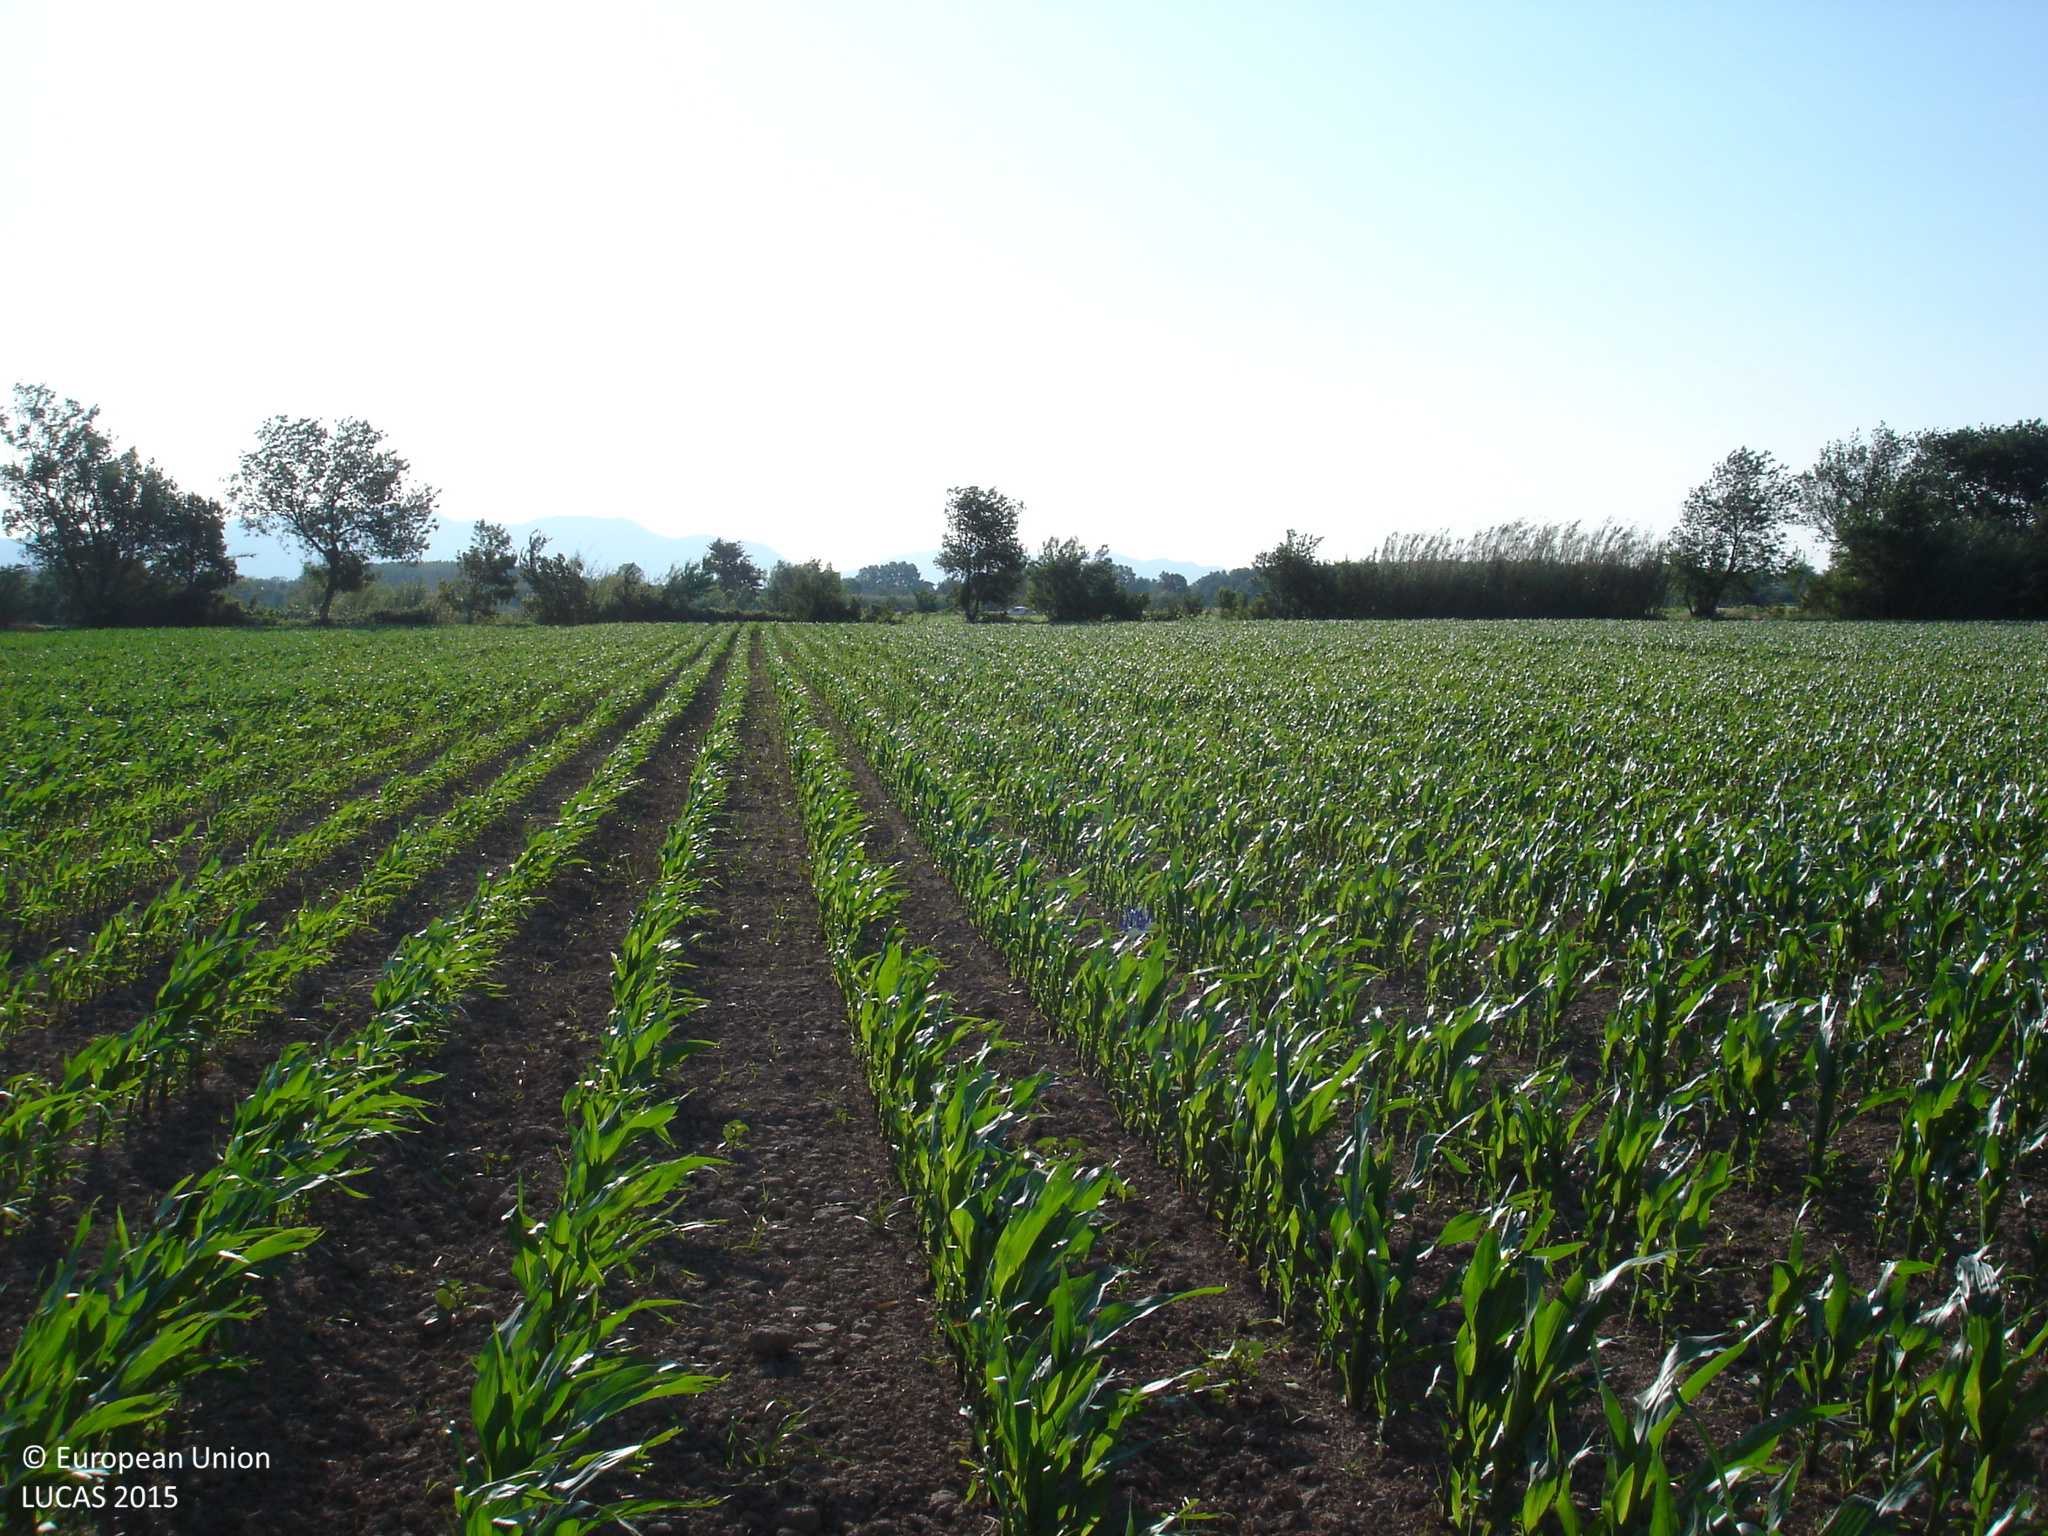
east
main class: Cropland
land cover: Maize
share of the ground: 25 - 50 %
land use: Agriculture (excluding fallow land and kitchen gardens)
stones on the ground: < 10 %
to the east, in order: Maize; Groves; Maize; Grass margins; Tracks; Grass margins; Lucerne; Grass margins; Lucerne
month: May
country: ES
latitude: 42.3023
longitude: 2.9906
